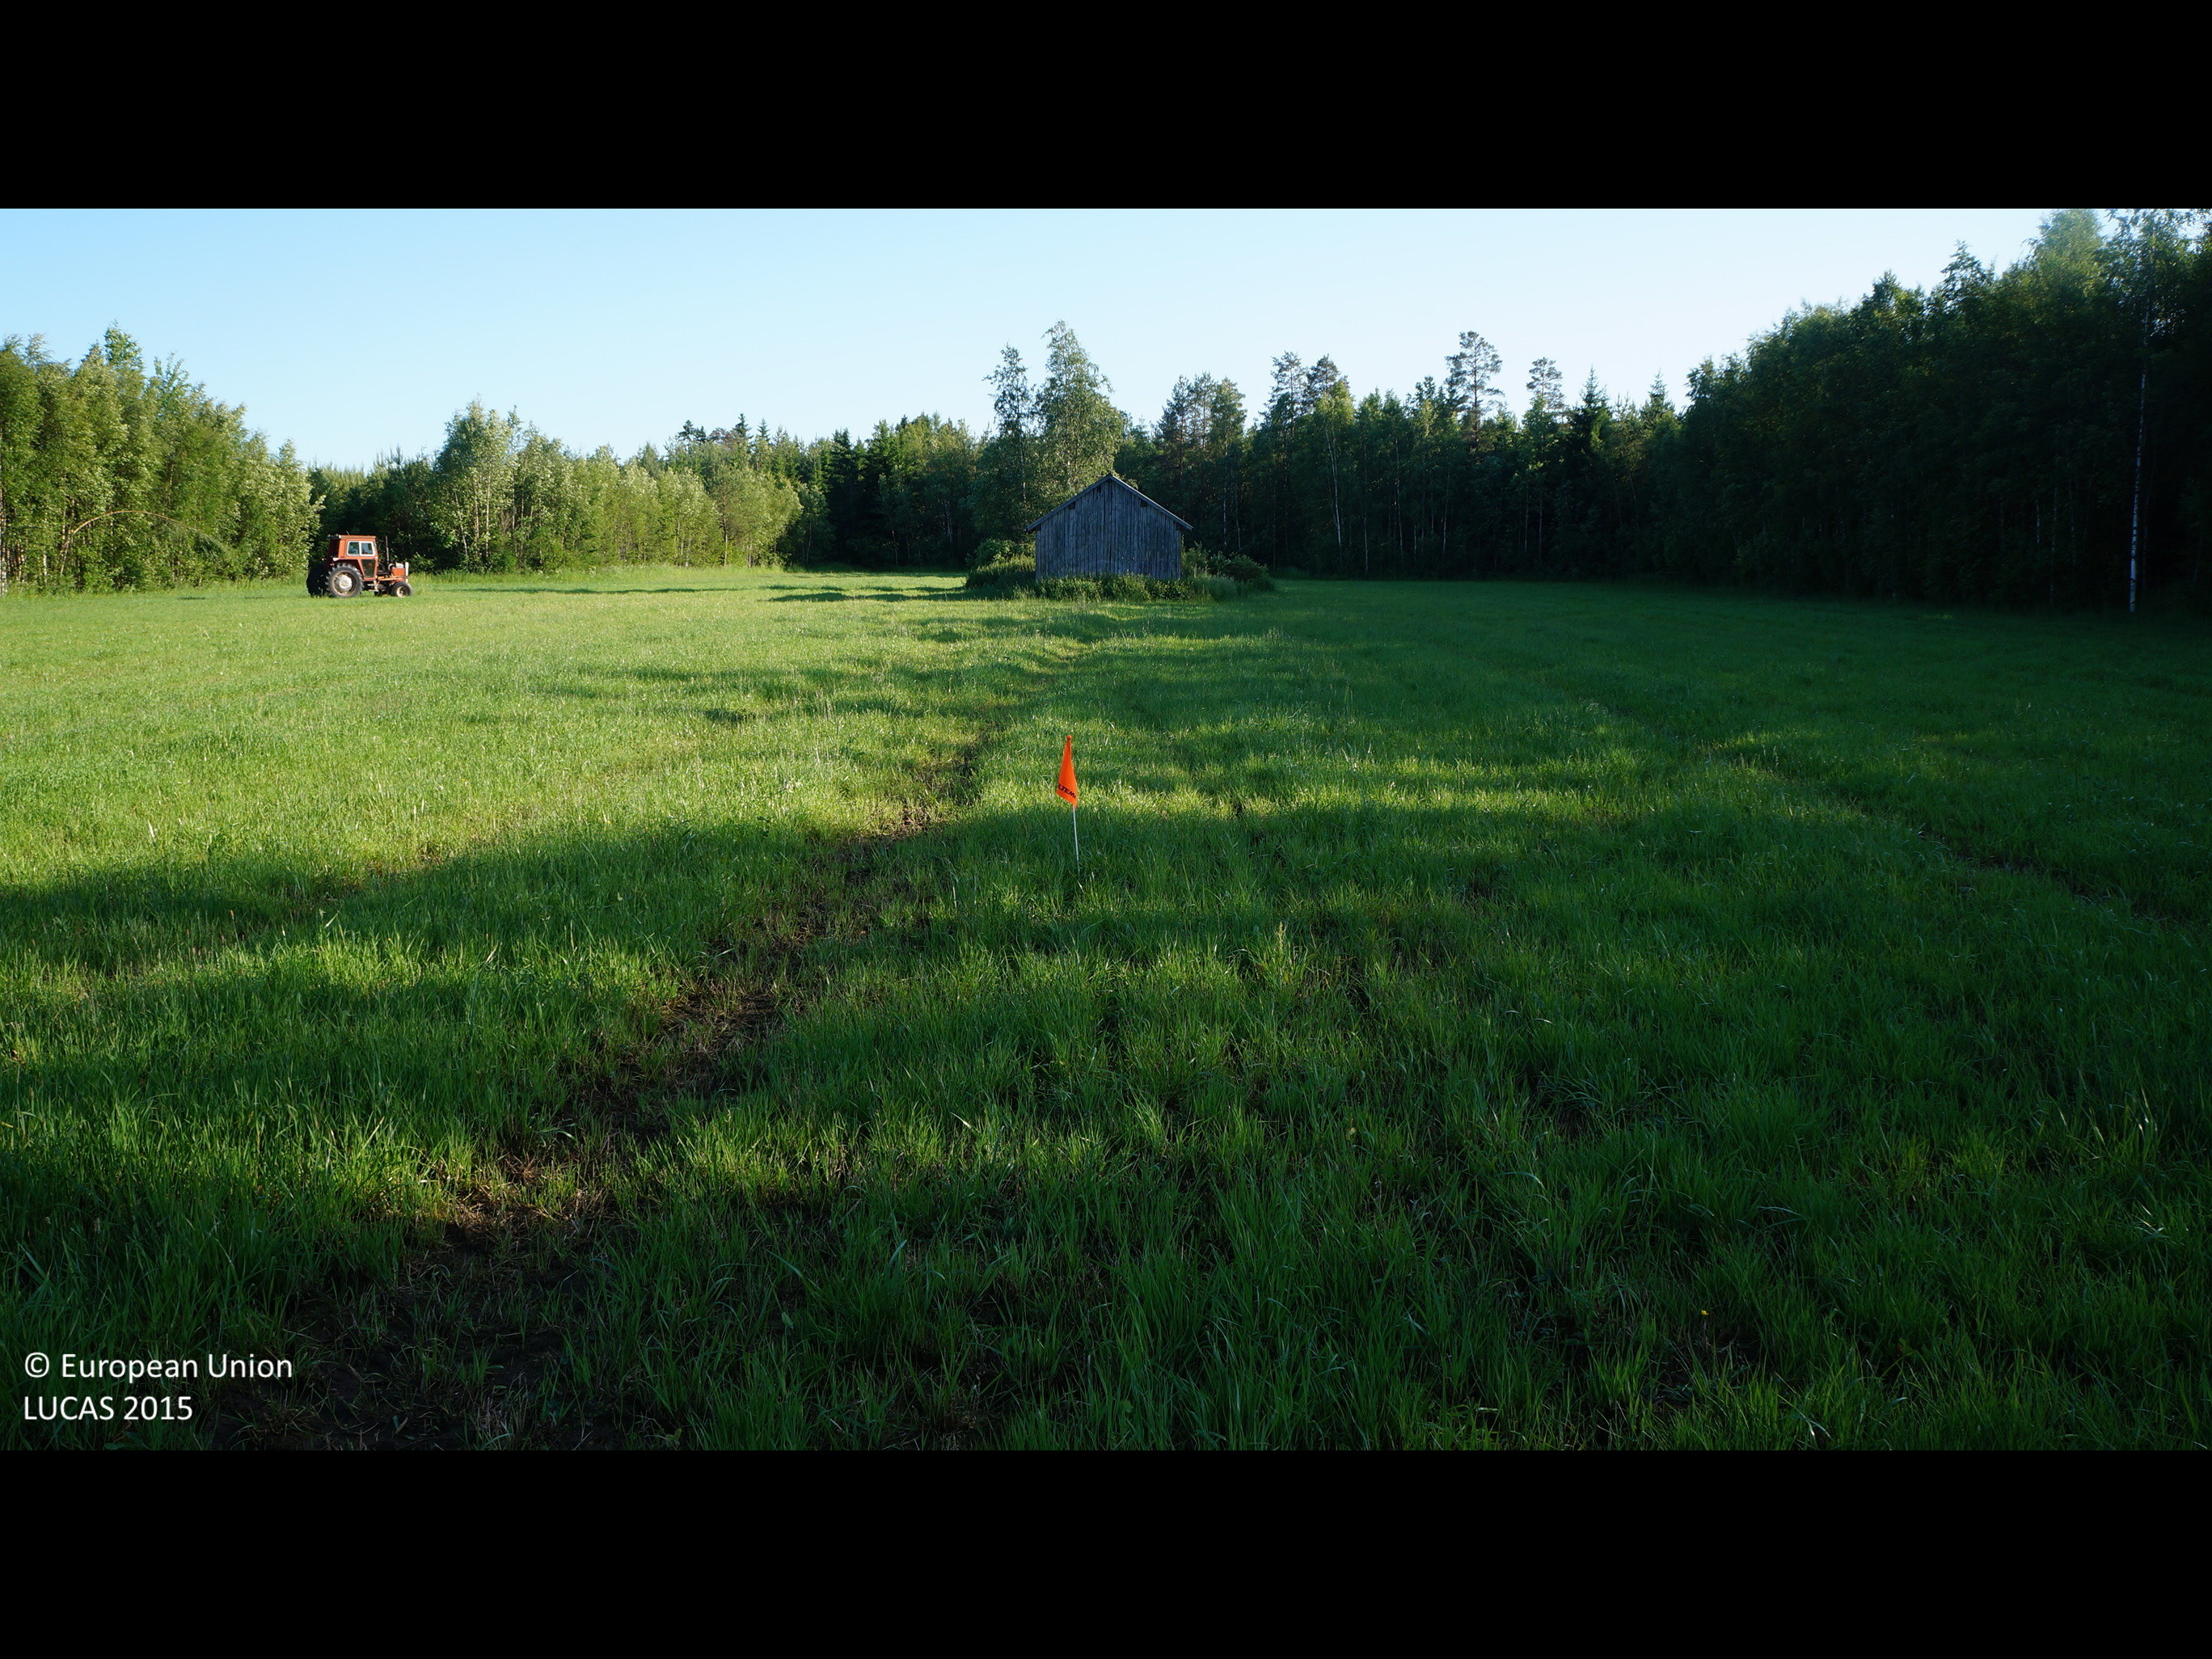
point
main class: Cropland
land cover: Temporary grasslands
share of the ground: 50 - 75 %
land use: Agriculture (excluding fallow land and kitchen gardens)
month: July
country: FI
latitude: 63.6511
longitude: 22.8745
